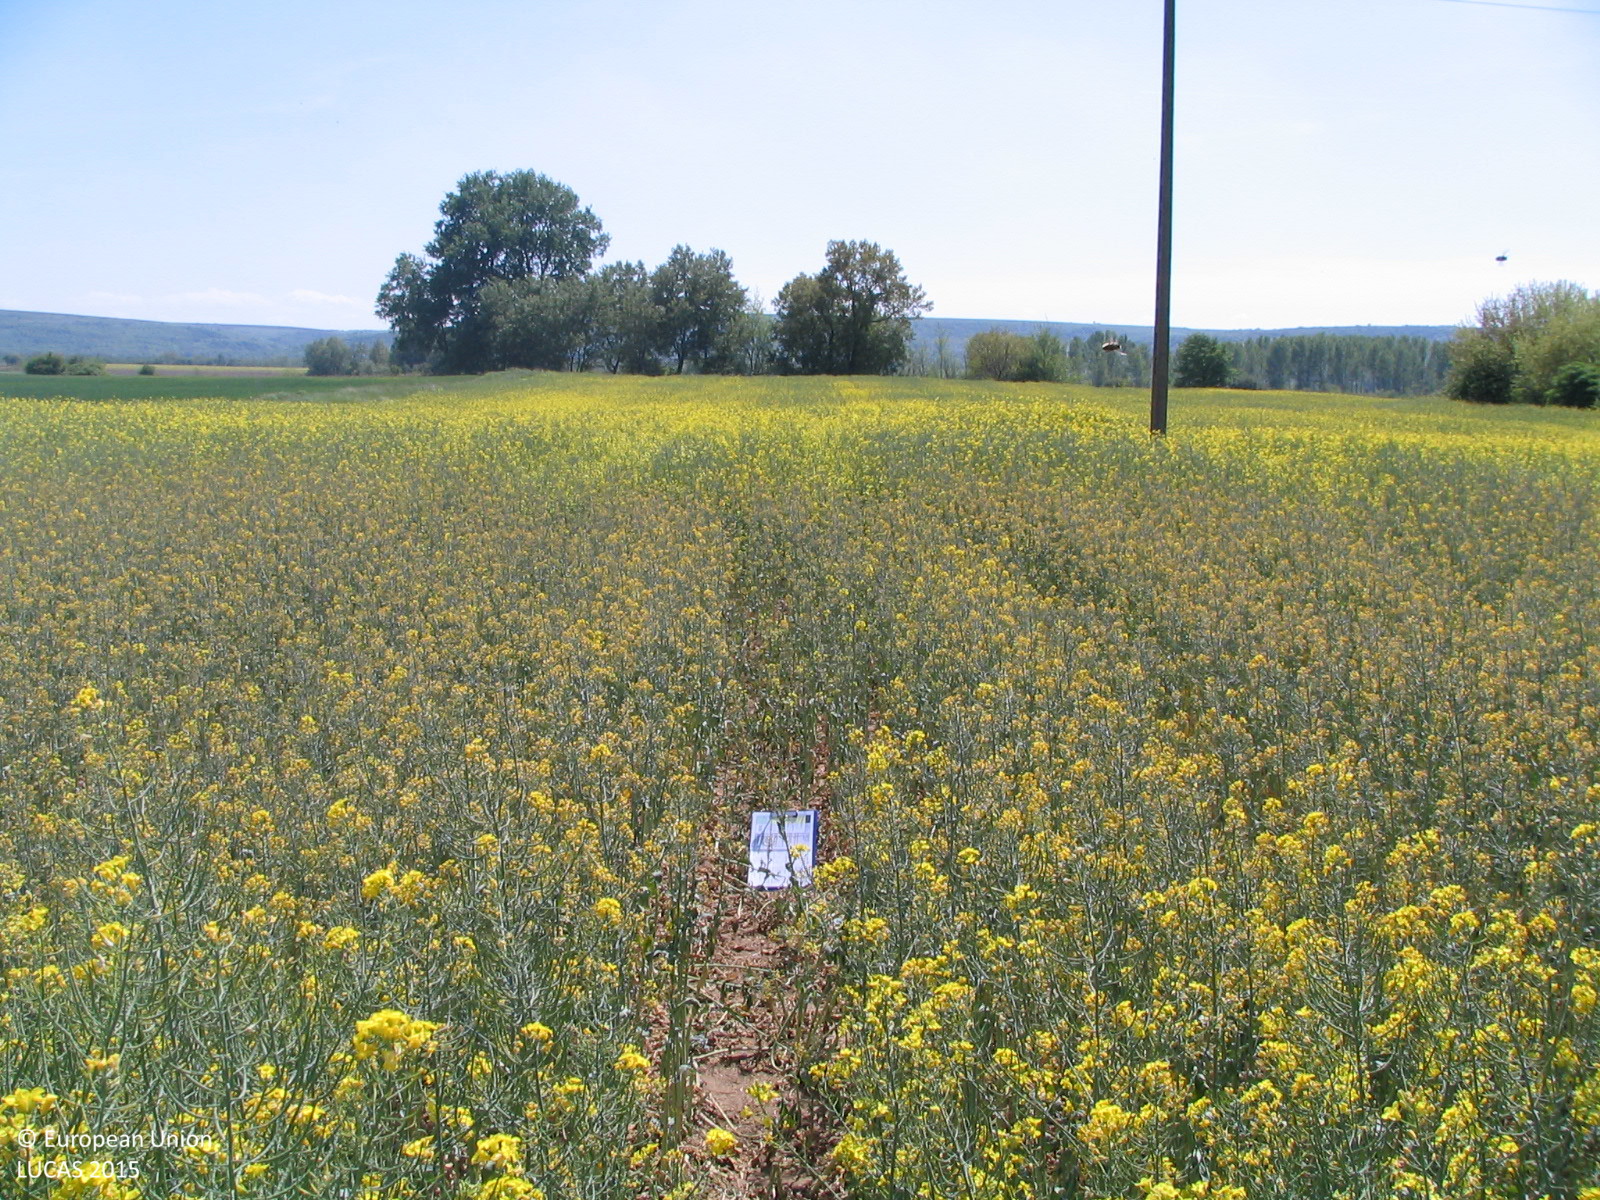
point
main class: Cropland
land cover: Rape and turnip rape
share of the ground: > 75 %
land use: Agriculture (excluding fallow land and kitchen gardens)
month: May
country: BG
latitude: 43.6946
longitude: 24.0889
